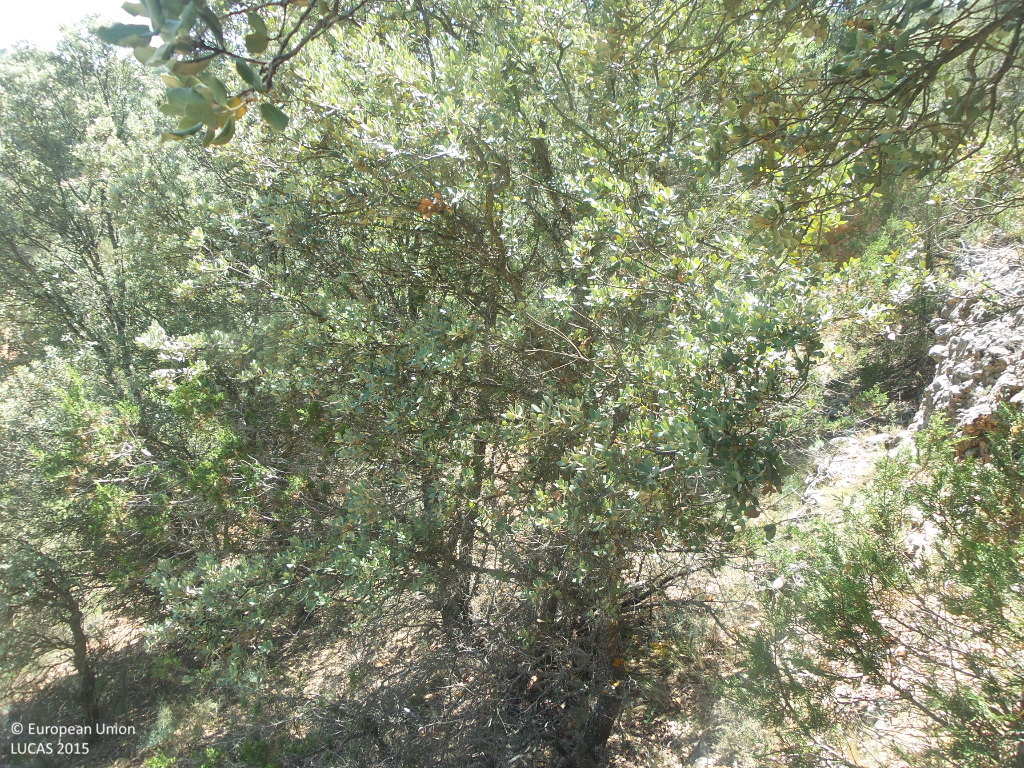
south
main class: Woodland
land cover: Other mixed woodland
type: broadleaved evergreen forest
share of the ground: 50 - 75 %
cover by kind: broadleaved forest trees 40 %, coniferous forest trees 20 %, shrubs 15 %, unconsolidated bare surface 15 %, herbaceous plants 5 %, consolidated bare surface 5 %
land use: Semi-natural and natural areas not in use
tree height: > 5 m
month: July
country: ES
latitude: 41.1323
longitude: -2.0223
